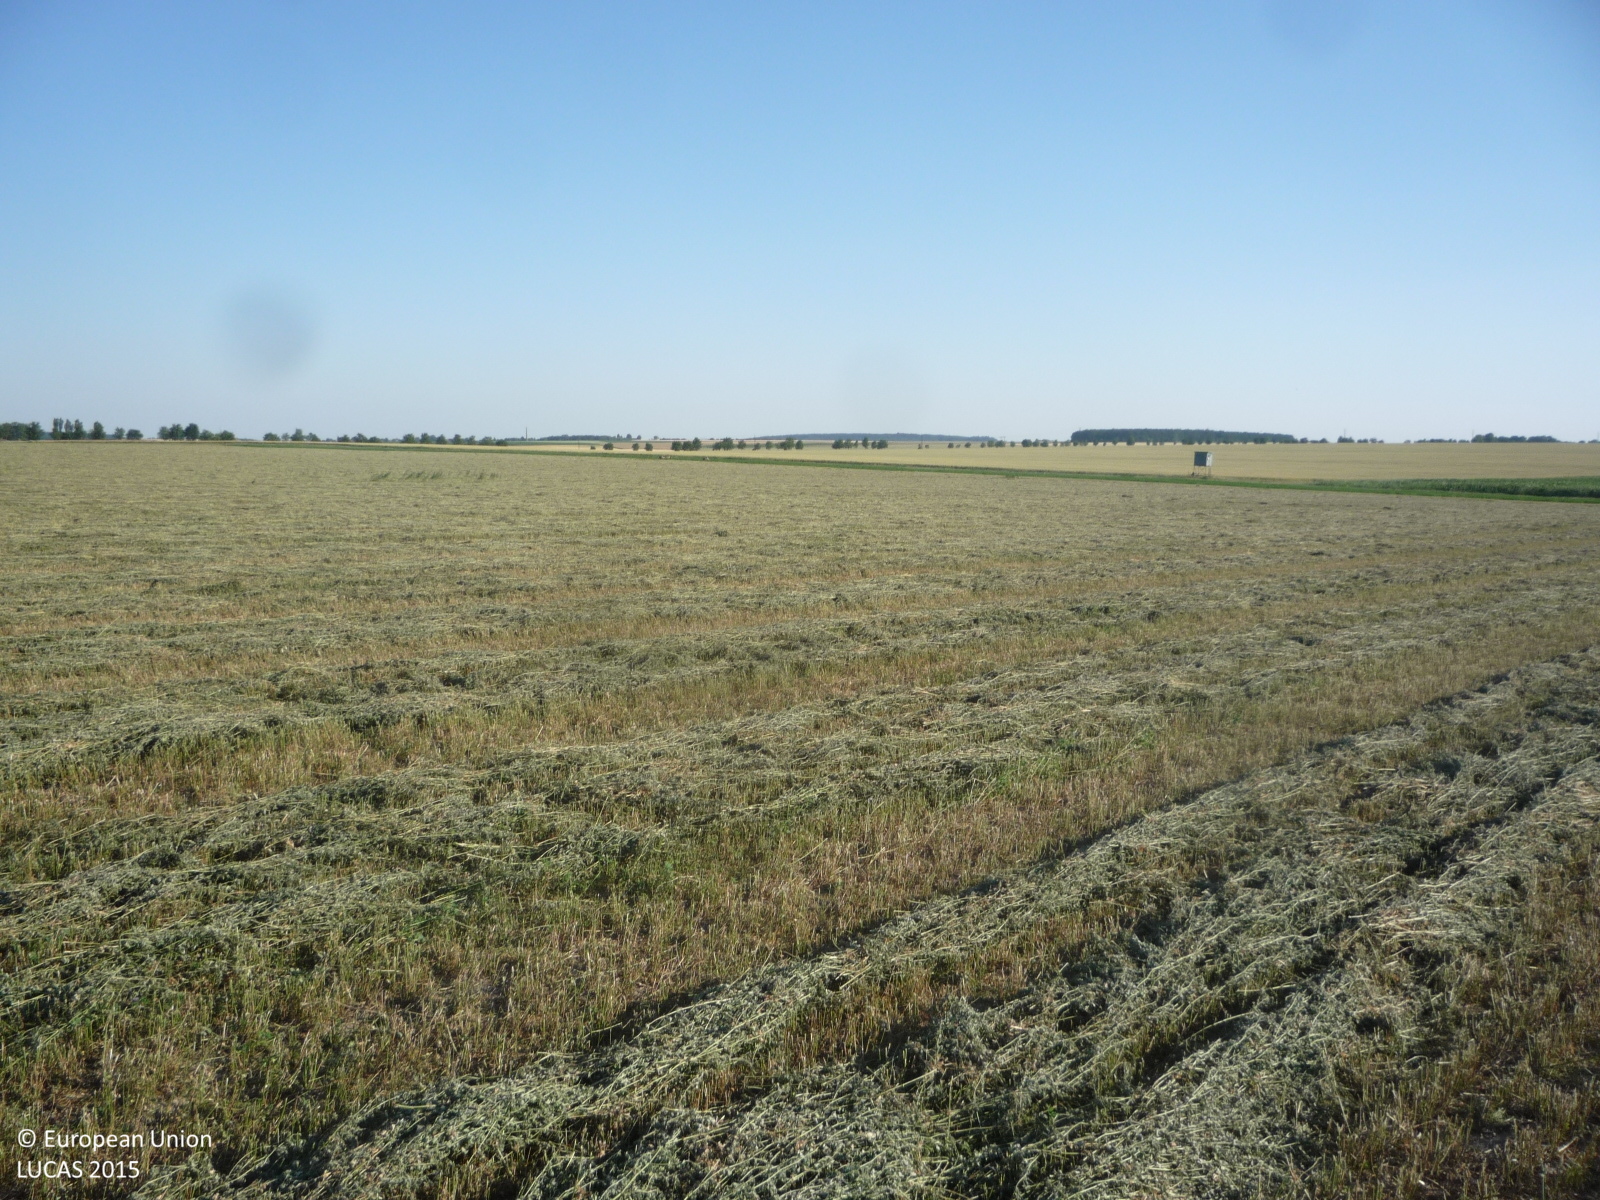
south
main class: Cropland
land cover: Lucerne
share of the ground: > 75 %
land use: Agriculture (excluding fallow land and kitchen gardens)
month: July
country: CZ
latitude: 50.2071
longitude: 15.2578
